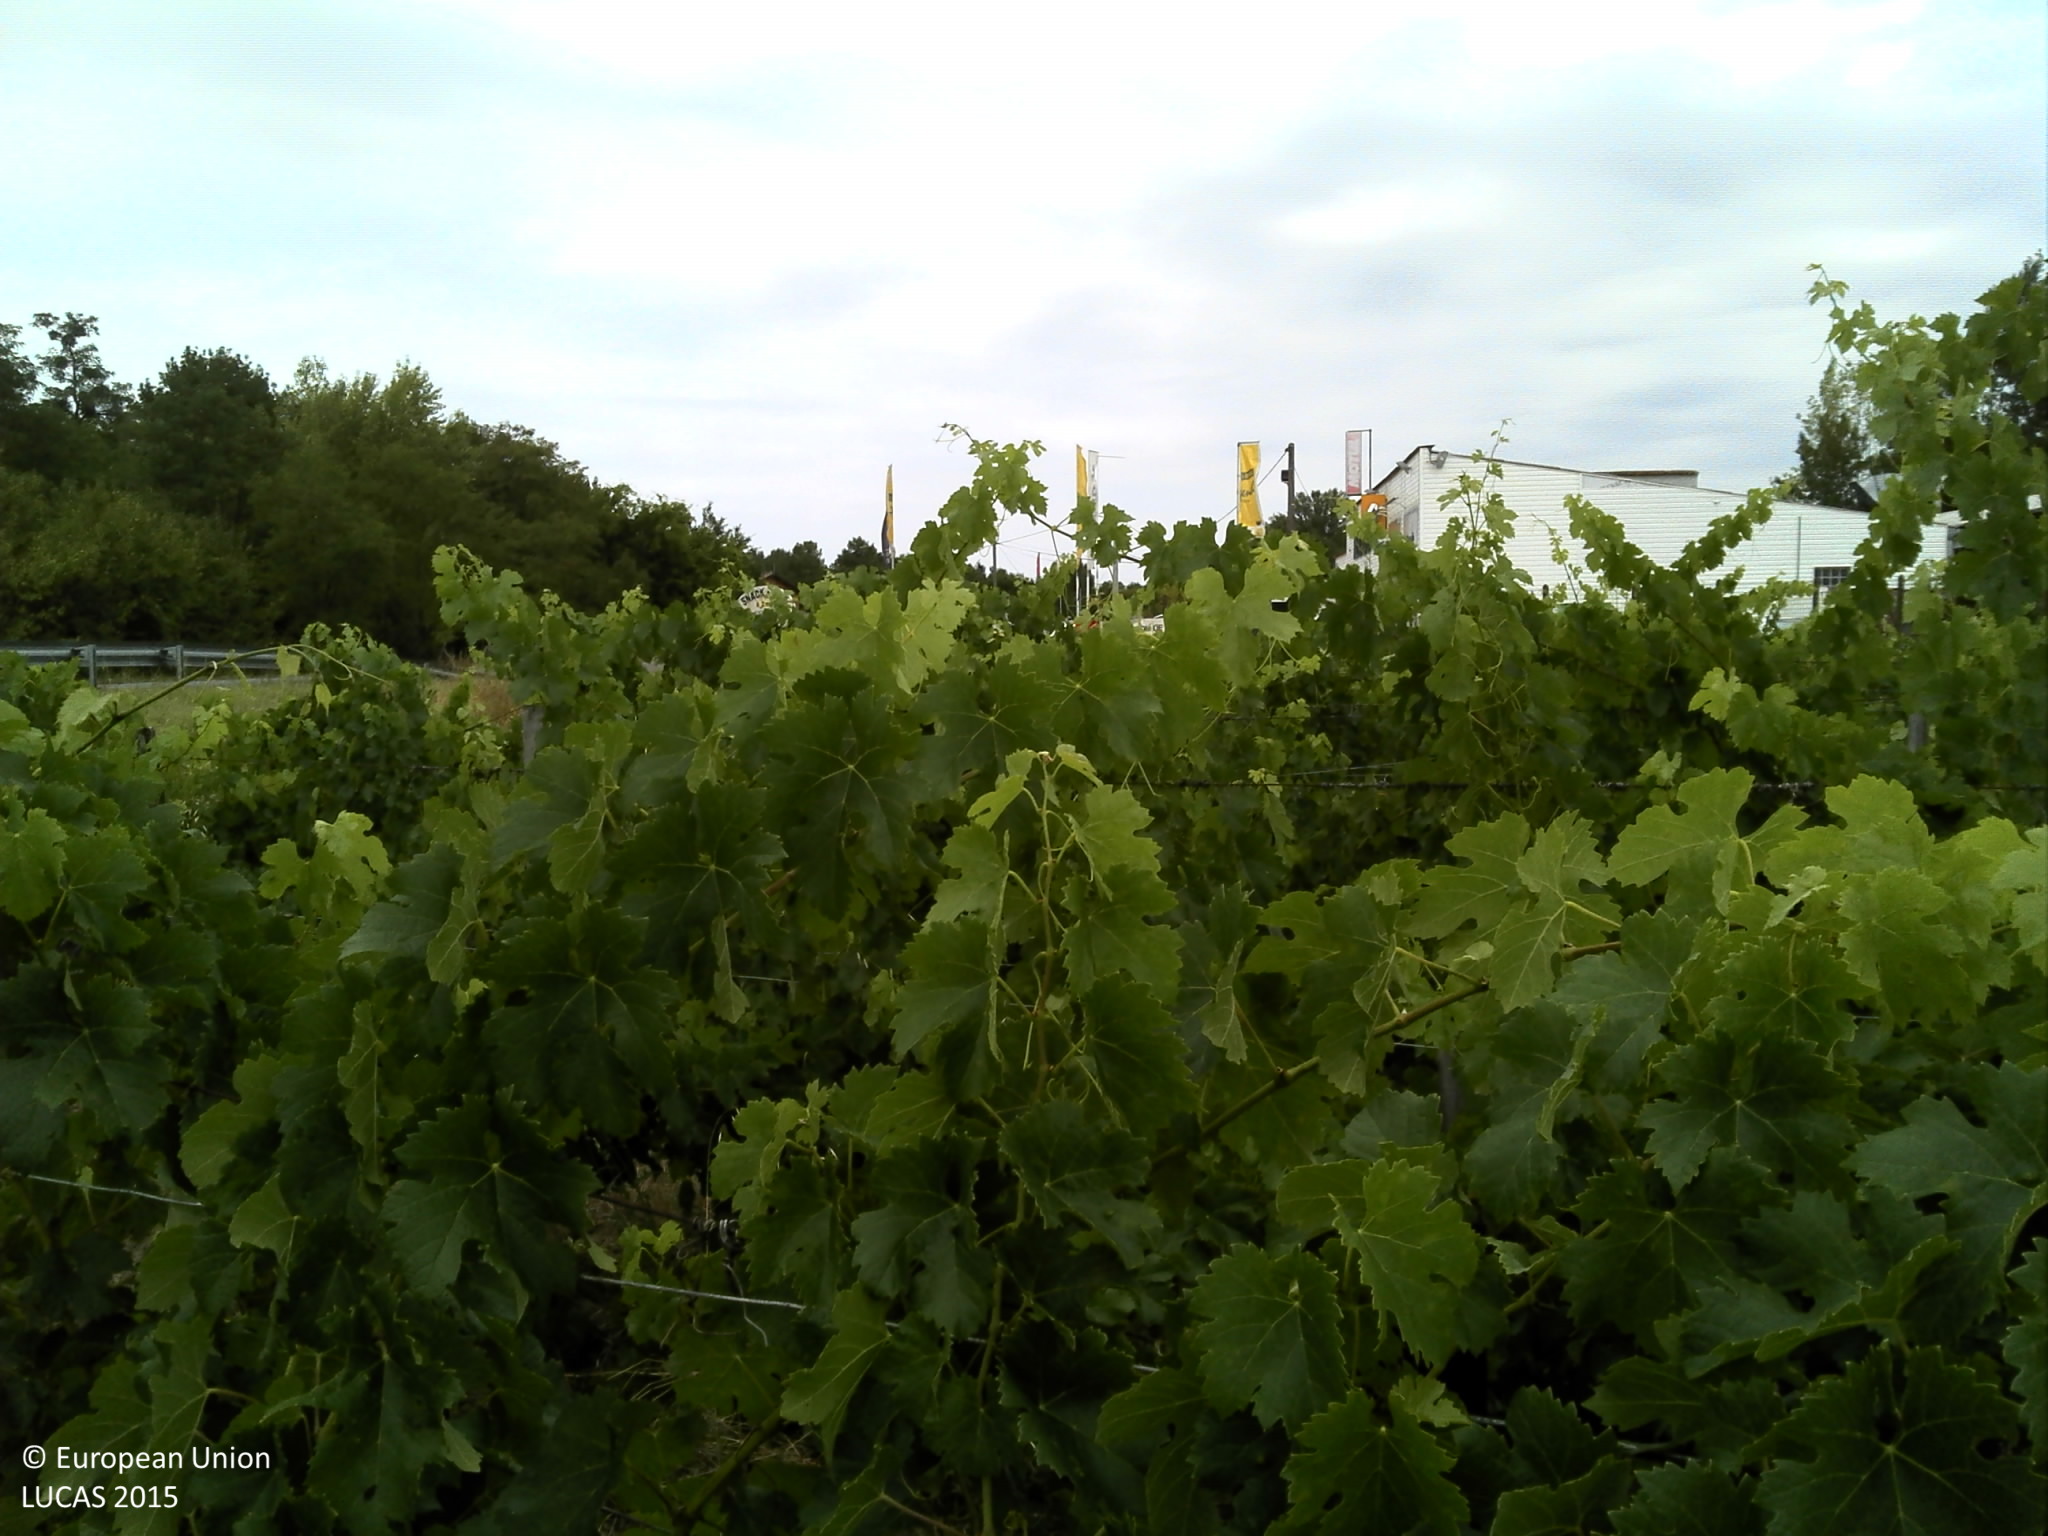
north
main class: Cropland
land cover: Vineyards
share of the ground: 50 - 75 %
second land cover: Grassland without tree/shrub cover
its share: 25 - 50 %
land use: Agriculture (excluding fallow land and kitchen gardens)
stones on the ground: < 10 %
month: August
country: FR
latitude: 45.1697
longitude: -0.5938
